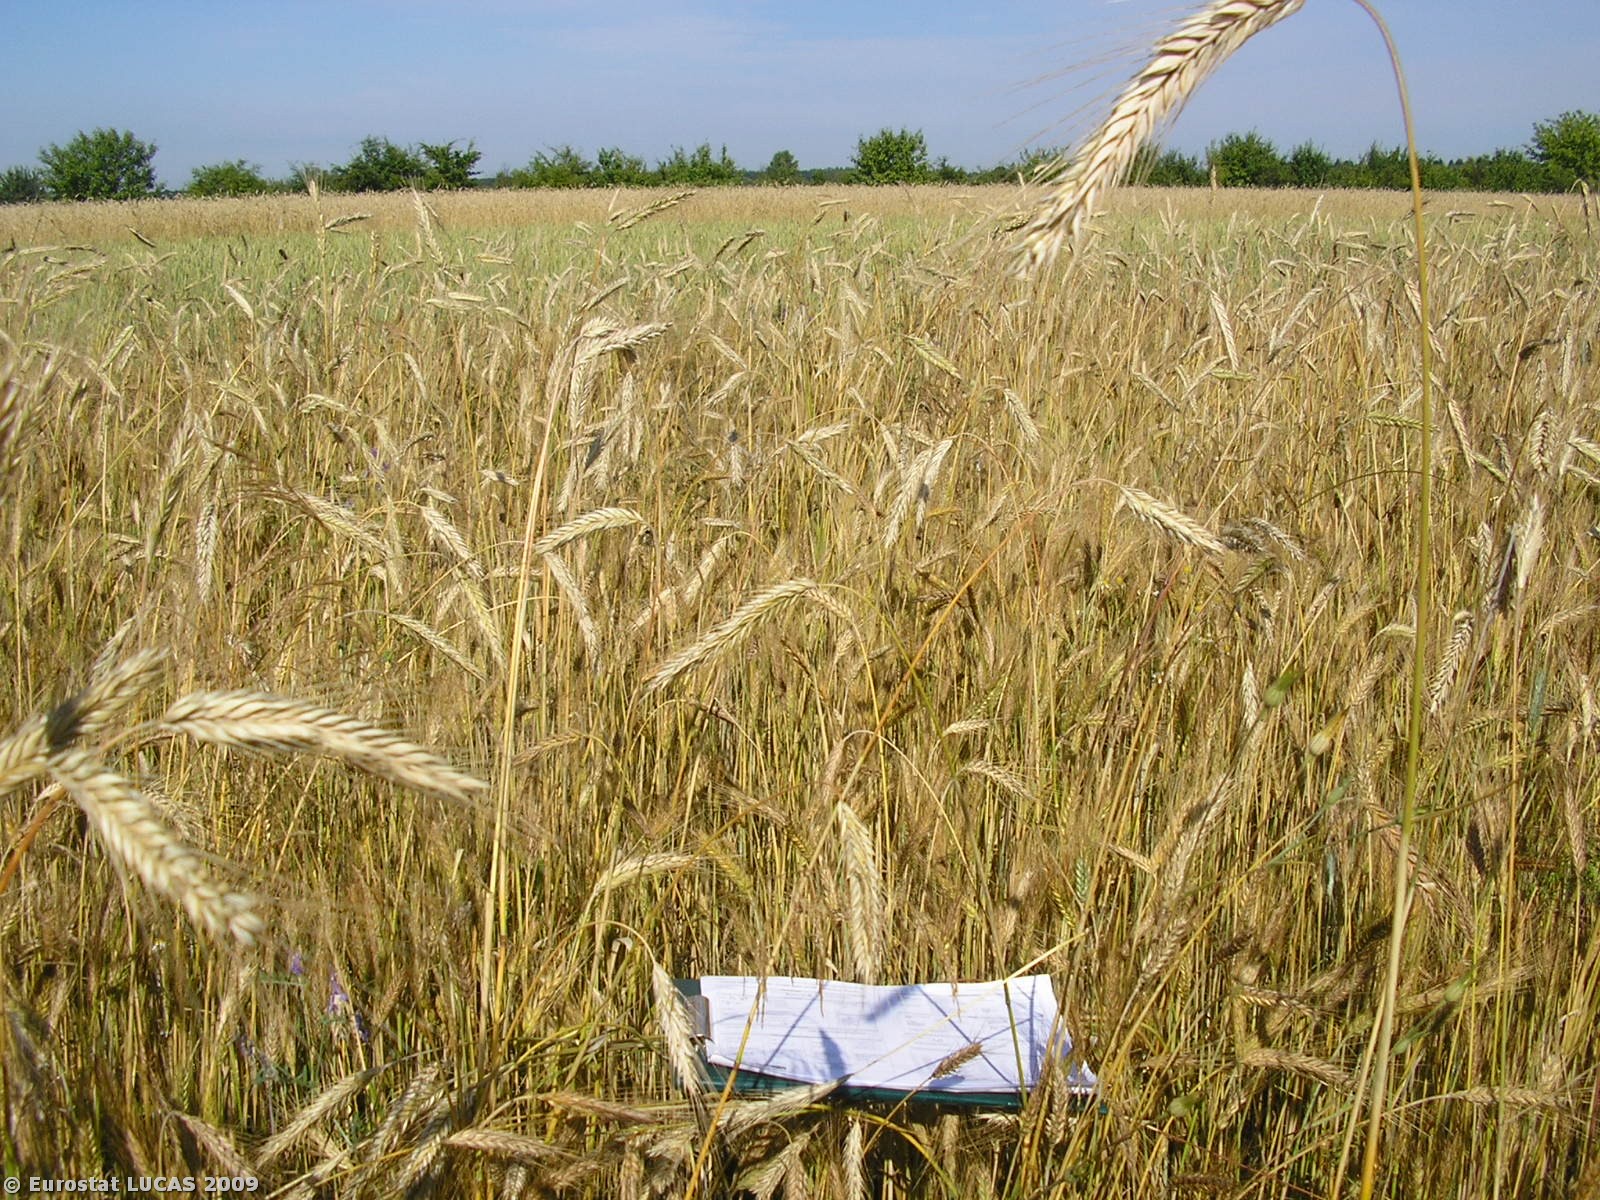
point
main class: Cropland
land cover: Triticale
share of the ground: > 75 %
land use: Agriculture (excluding fallow land and kitchen gardens)
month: July
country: PL
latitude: 52.4841
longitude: 20.7763
